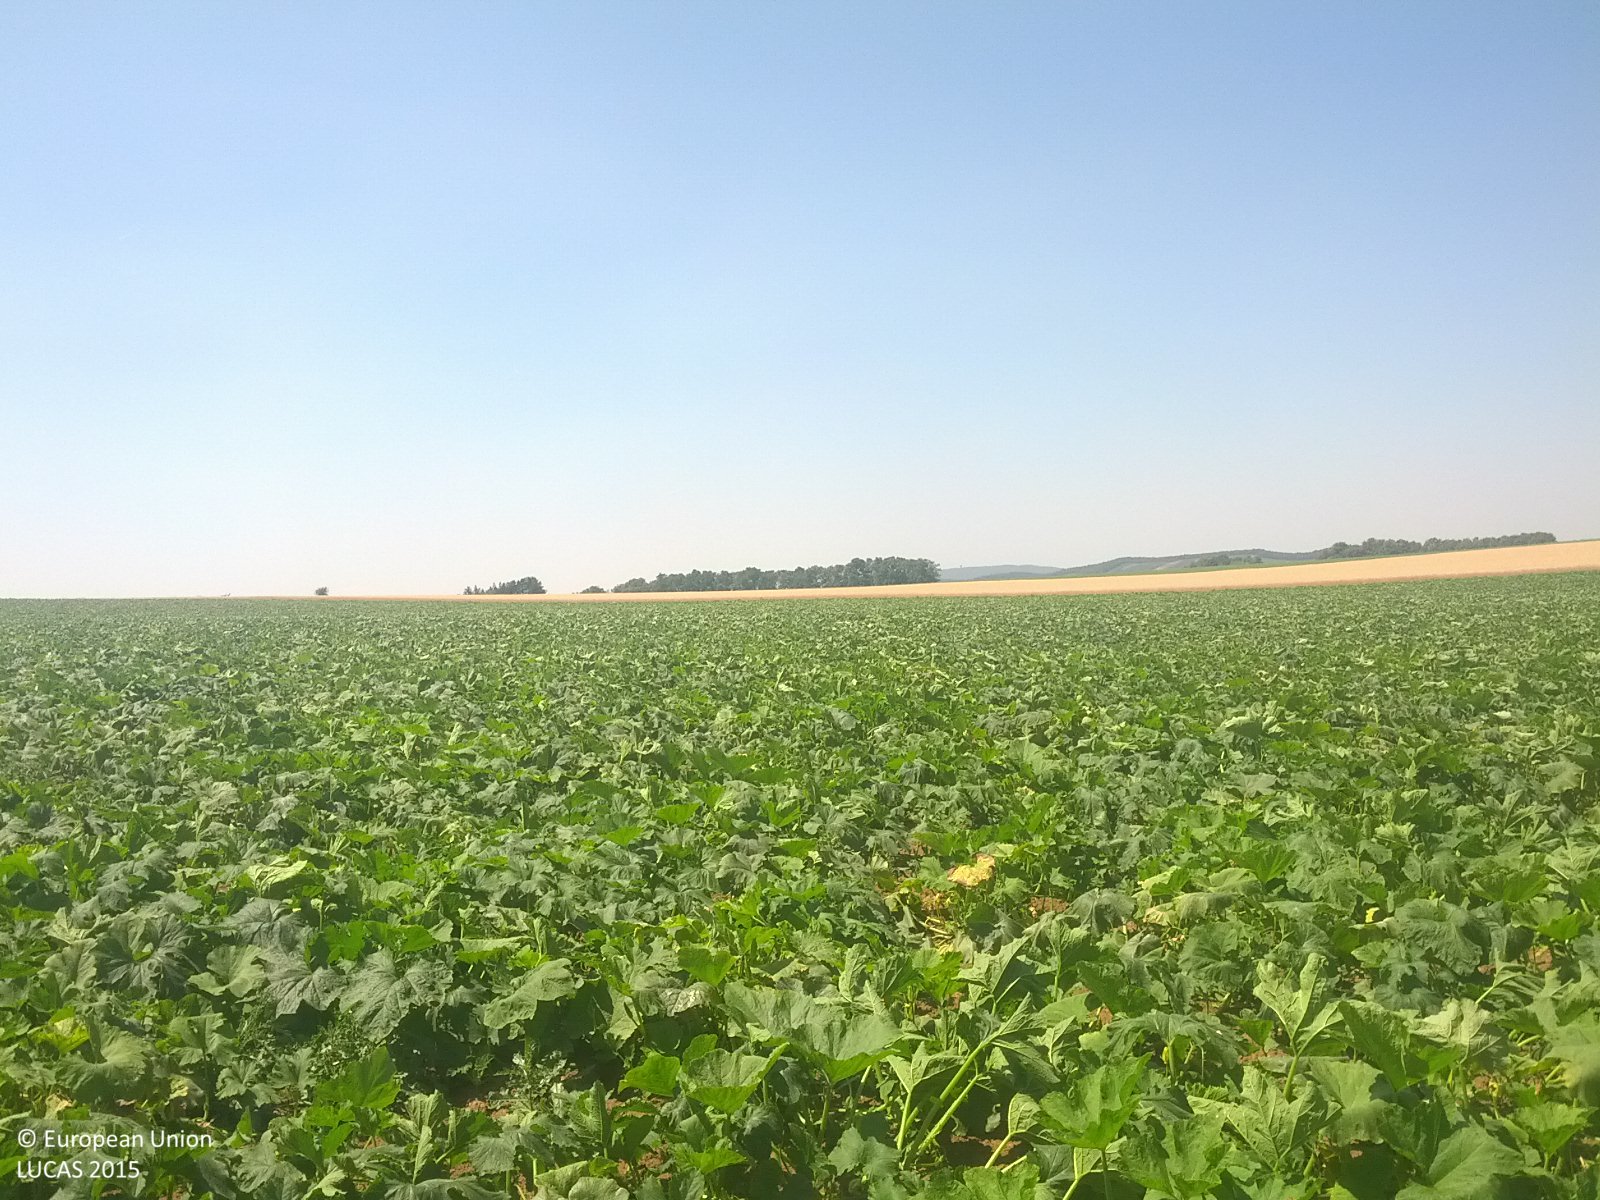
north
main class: Cropland
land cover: Other fresh vegetables
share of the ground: > 75 %
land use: Agriculture (excluding fallow land and kitchen gardens)
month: July
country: AT
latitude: 48.5327
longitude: 16.5744
